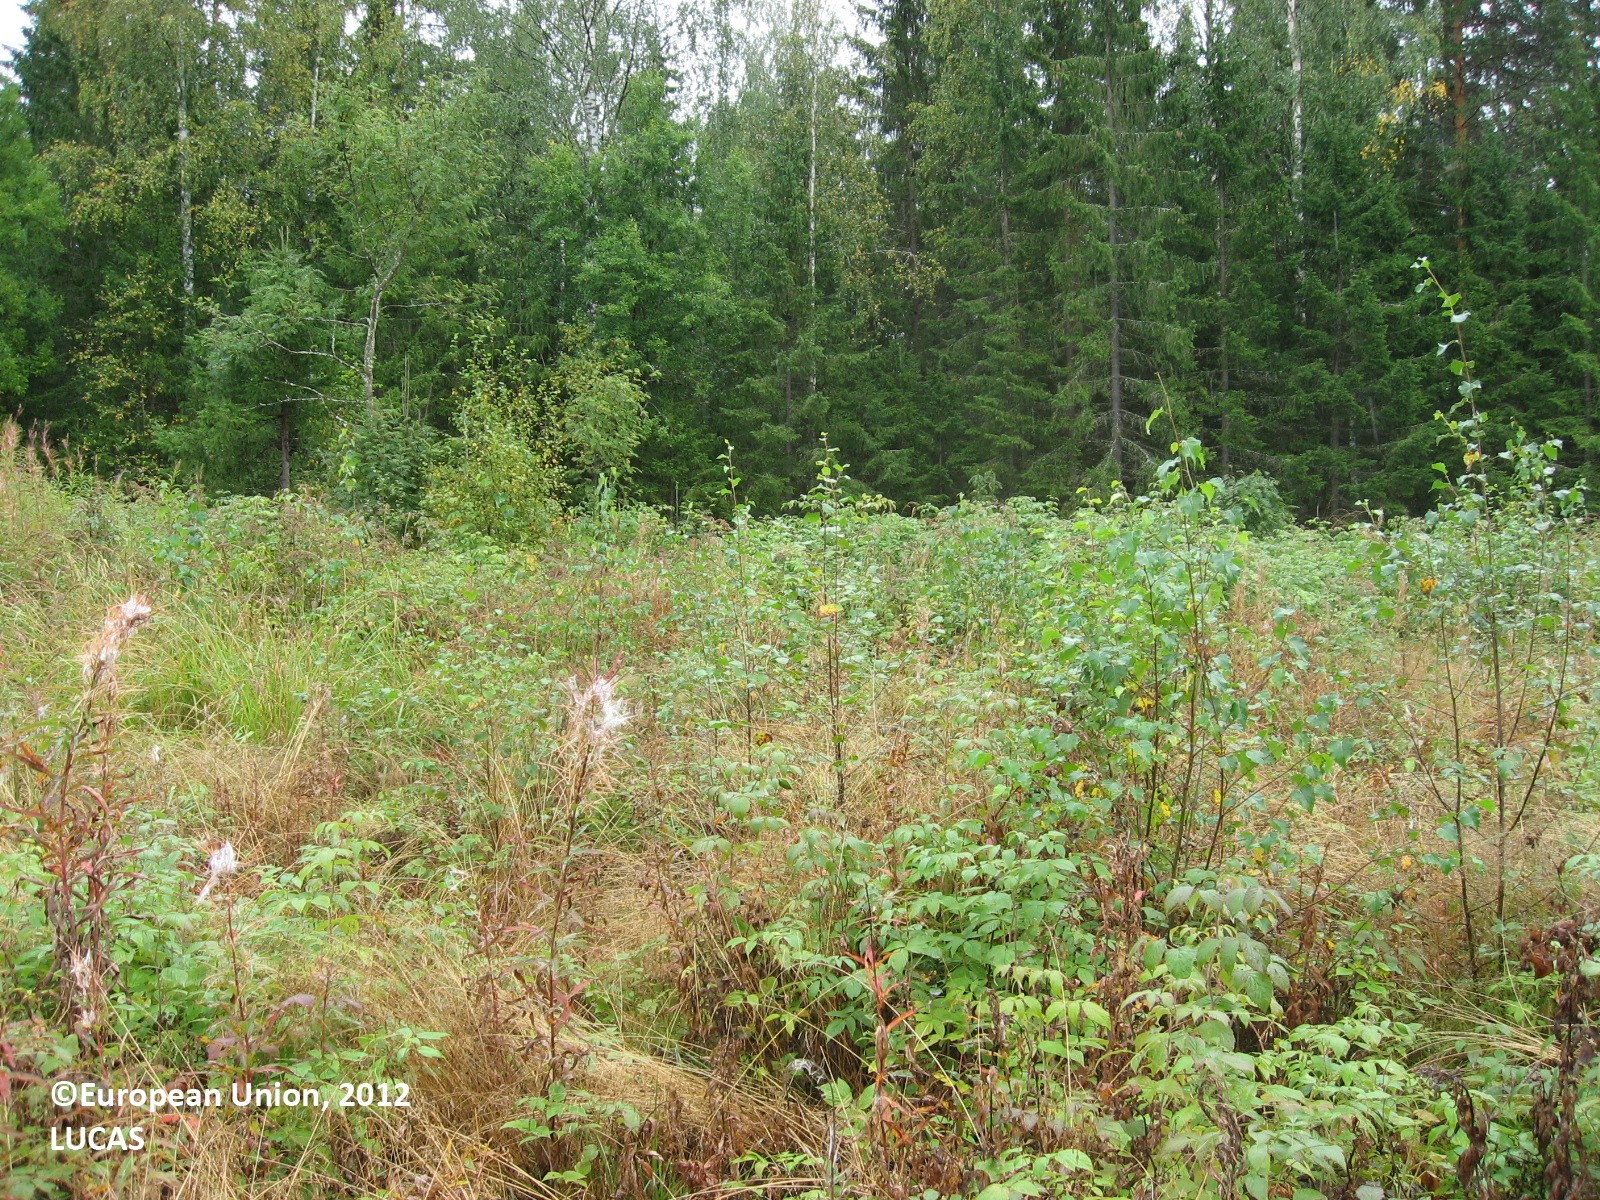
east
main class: Shrubland
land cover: Shrubland with sparse tree cover
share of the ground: > 75 %
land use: Forestry
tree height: < 5 m
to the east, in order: Shrubland with sparse tree cover; Grass margins; Paved roads, cycling and walking lanes; Grass margins; Spruce dominated coniferous woodland; Ditches and canals; Spruce dominated mixed woodland
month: August
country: FI
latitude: 61.4213
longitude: 24.7398
